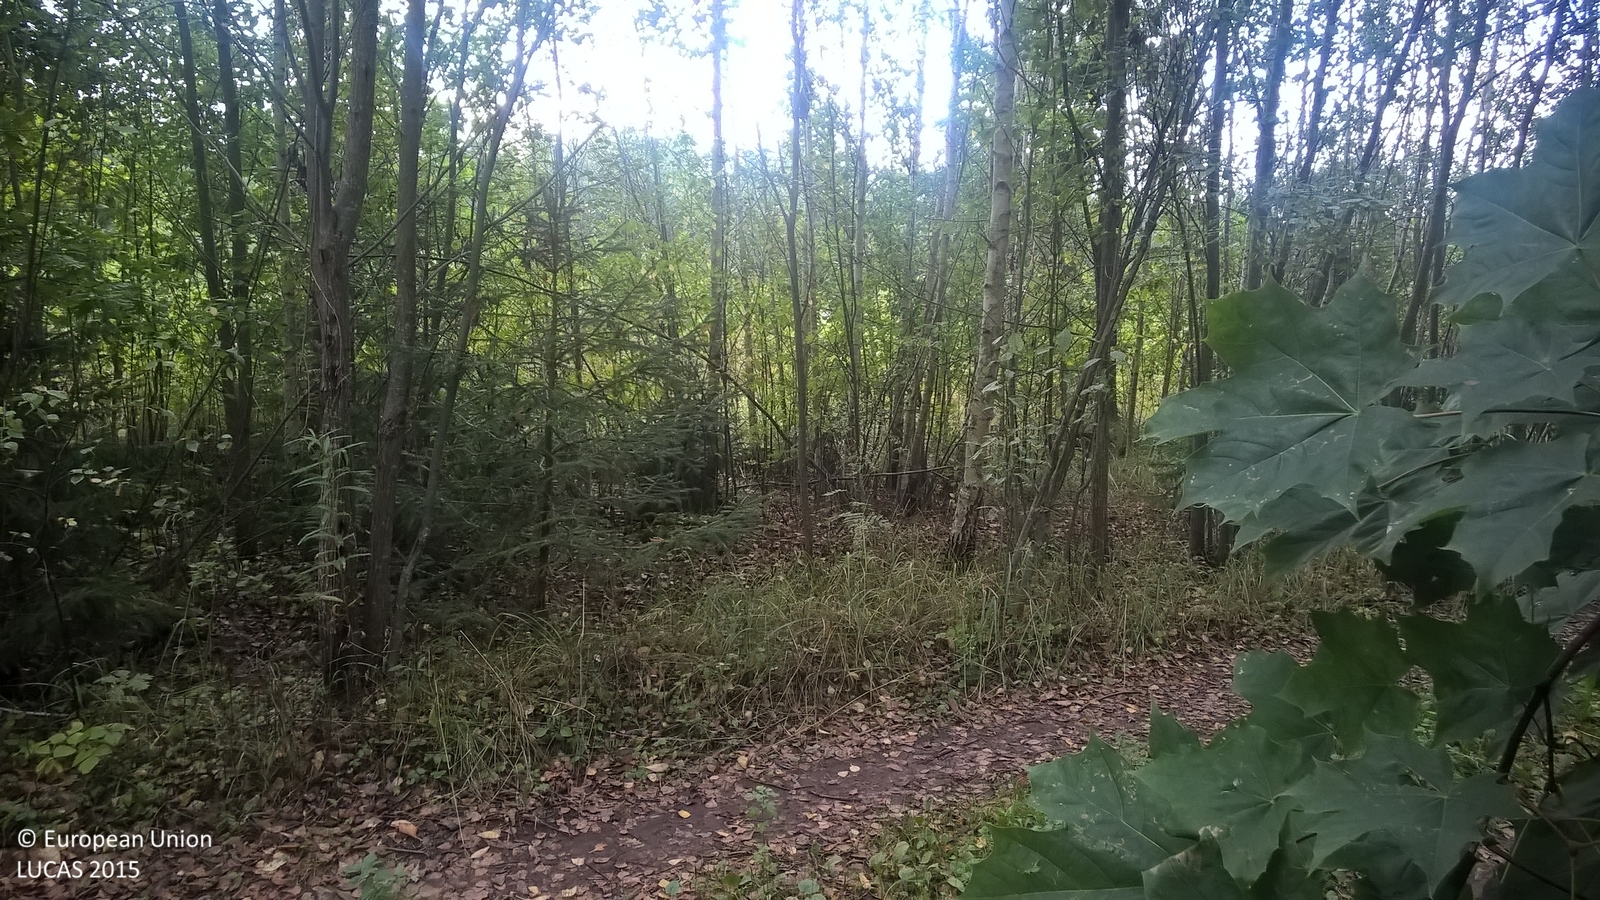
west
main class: Woodland
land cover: Broadleaved woodland
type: non-riverine alder, birch or aspen forest
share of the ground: > 75 %
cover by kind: broadleaved forest trees 85 %, herbaceous plants 10 %, shrubs 5 %
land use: Forestry
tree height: > 5 m
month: September
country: LV
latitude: 57.4841
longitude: 25.4425
